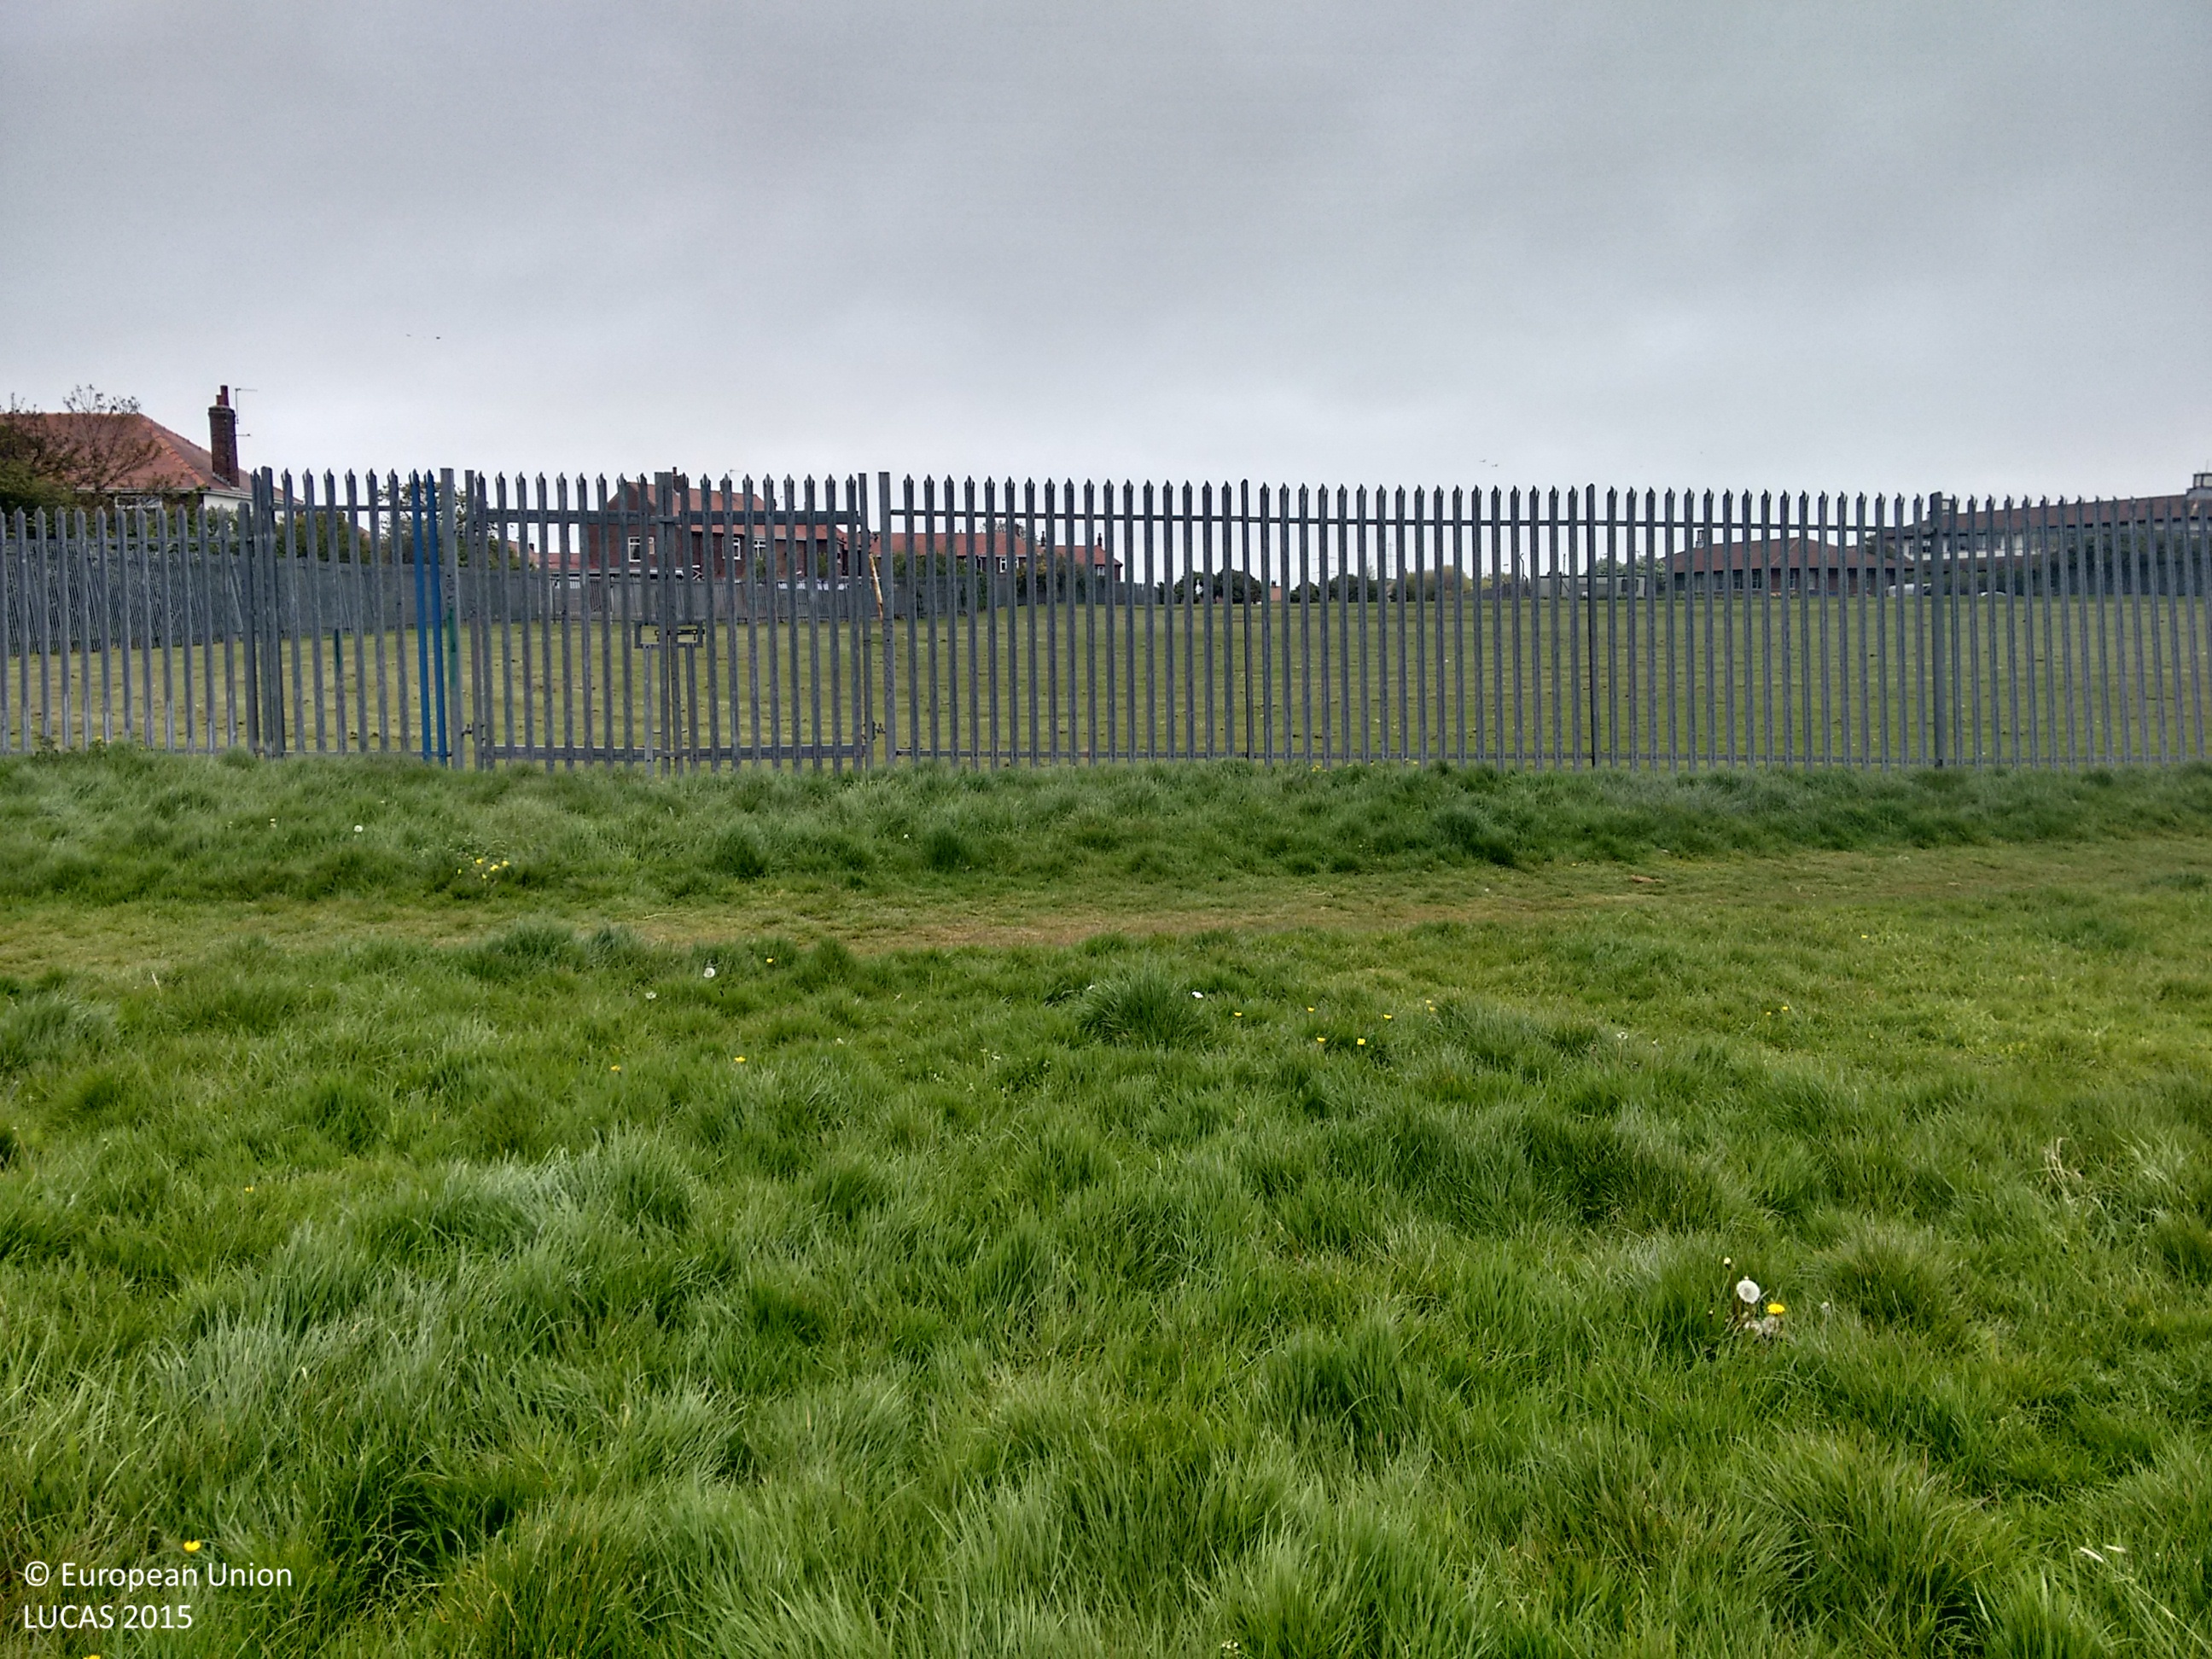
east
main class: Grassland
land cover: Grassland without tree/shrub cover
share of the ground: > 75 %
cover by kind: herbaceous plants 100 %
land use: Sport
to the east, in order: Grassland without tree/shrub cover; Fences; Grassland without tree/shrub cover; Managed hedges; Grassland without tree/shrub cover
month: May
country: GB
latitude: 53.8413
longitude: -3.0382
